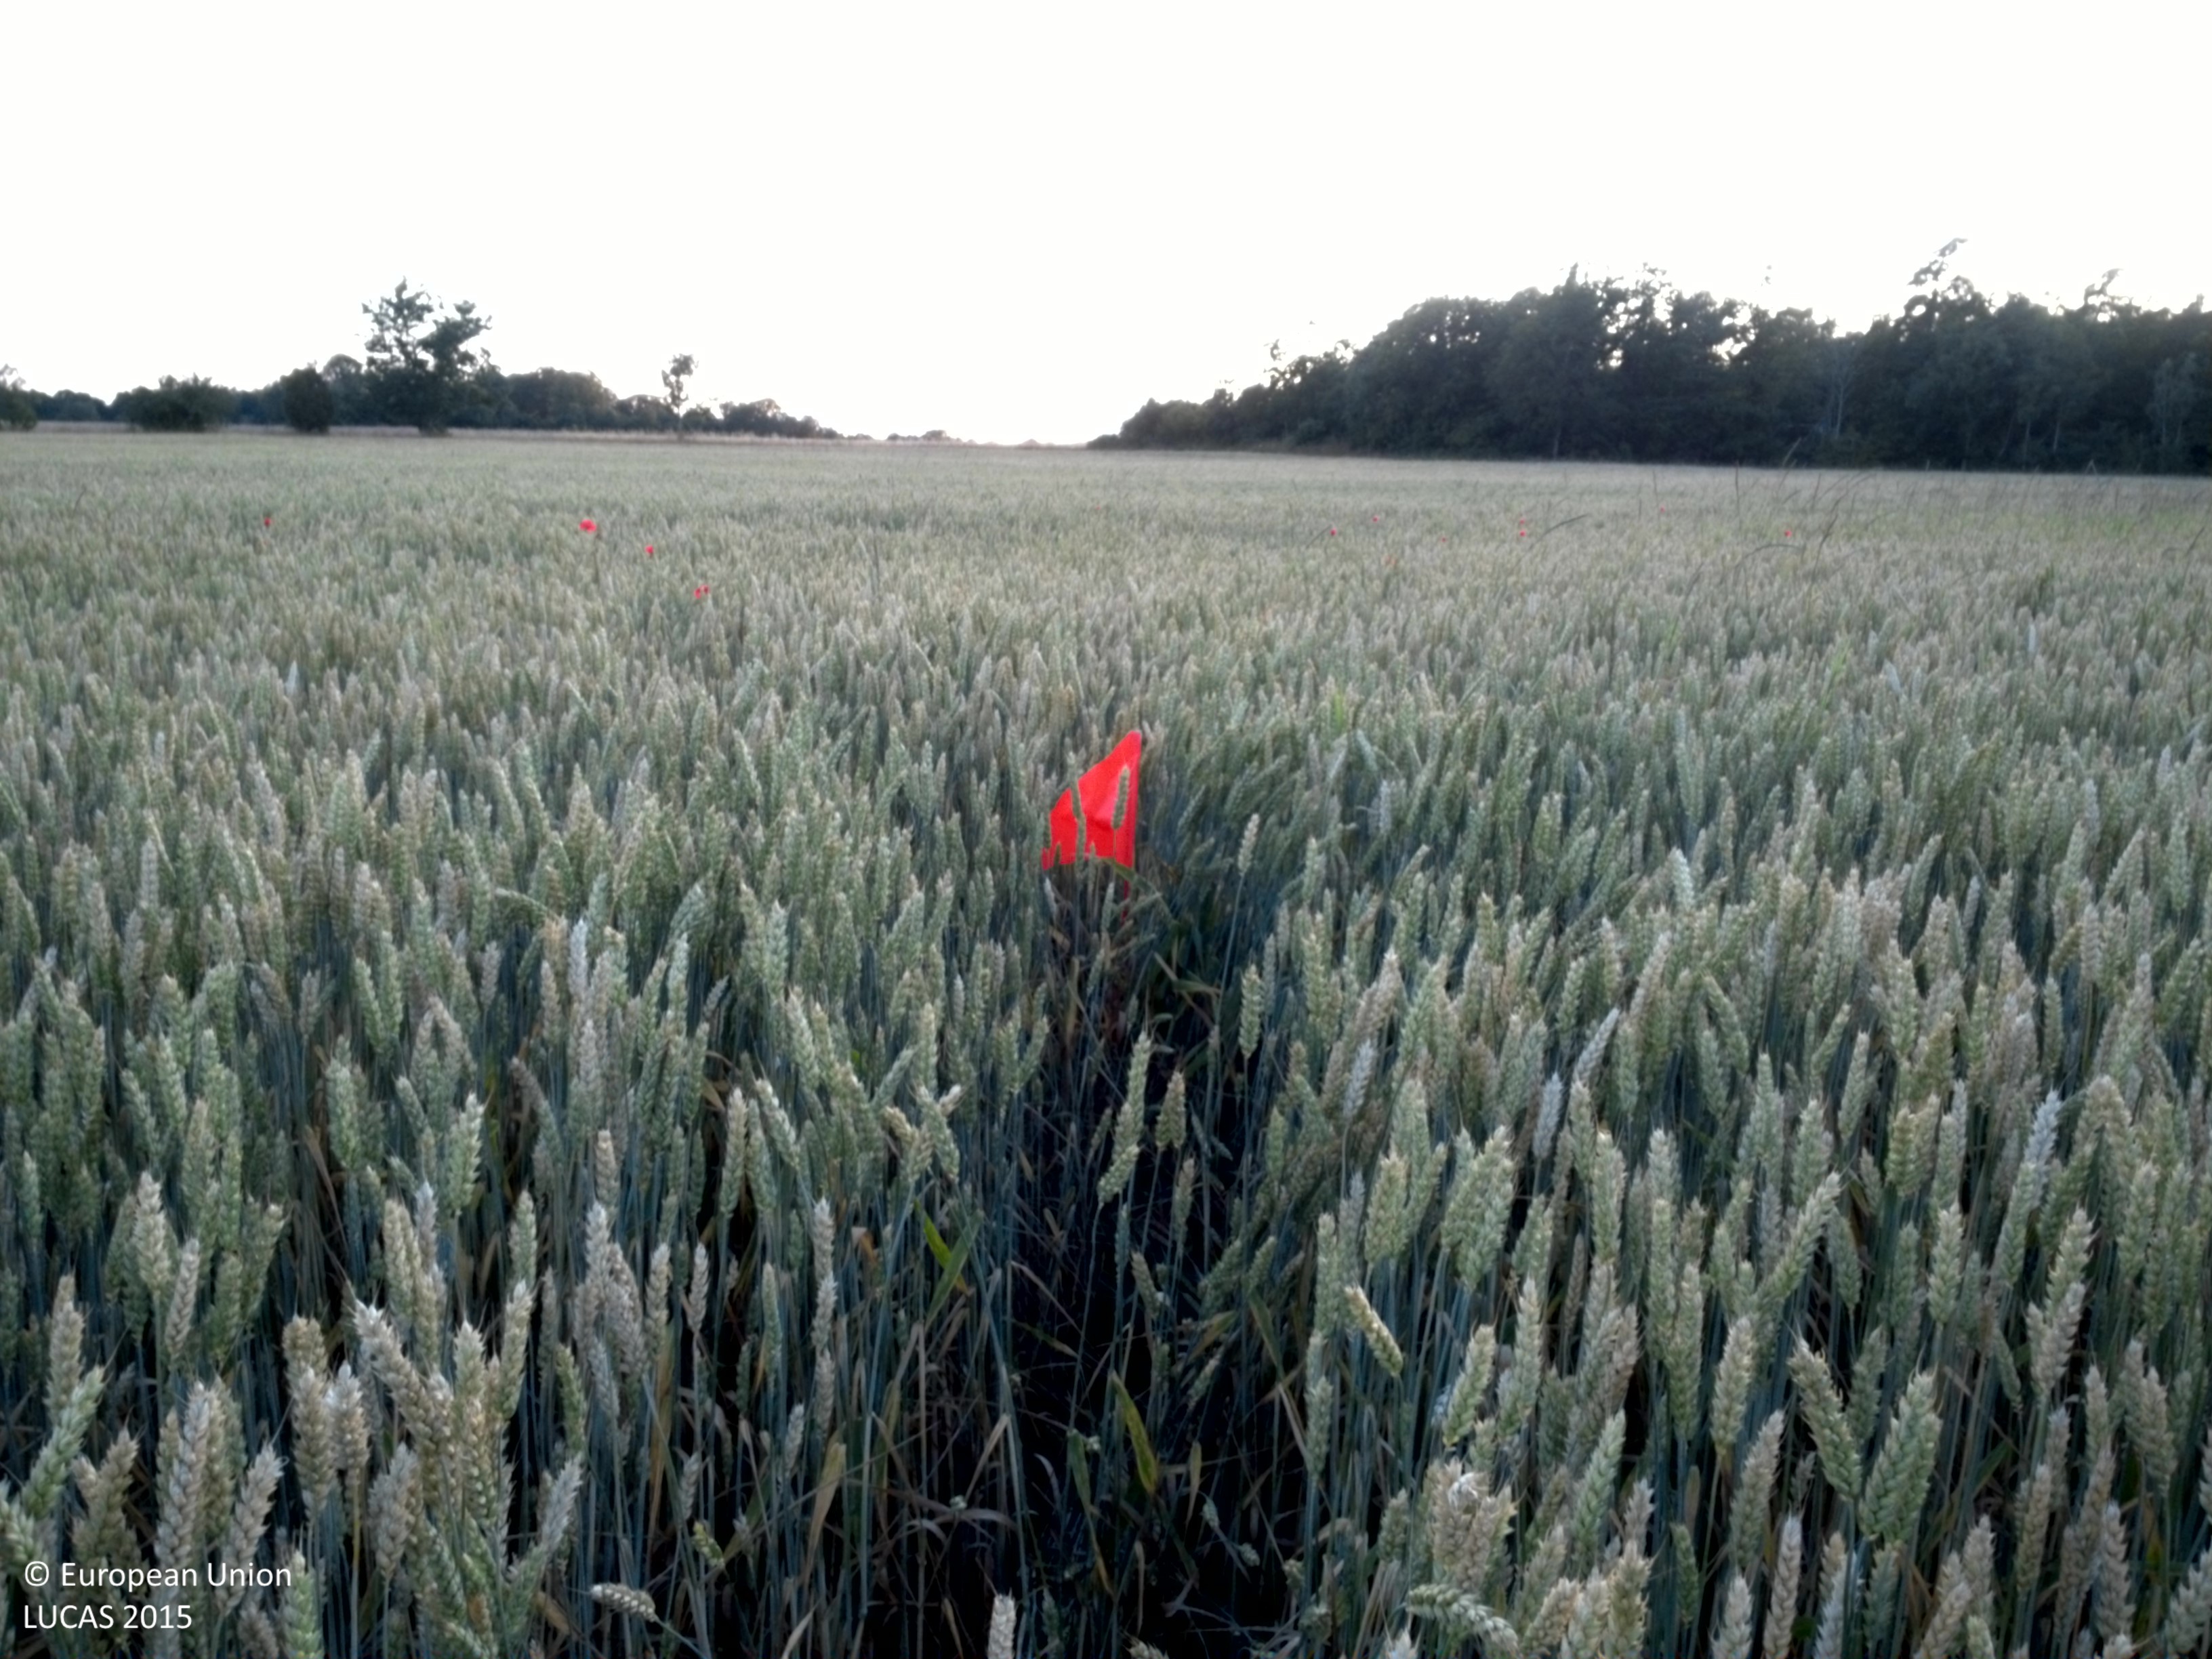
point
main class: Cropland
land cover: Common wheat
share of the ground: > 75 %
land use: Agriculture (excluding fallow land and kitchen gardens)
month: July
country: SE
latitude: 57.2835
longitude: 18.4529
